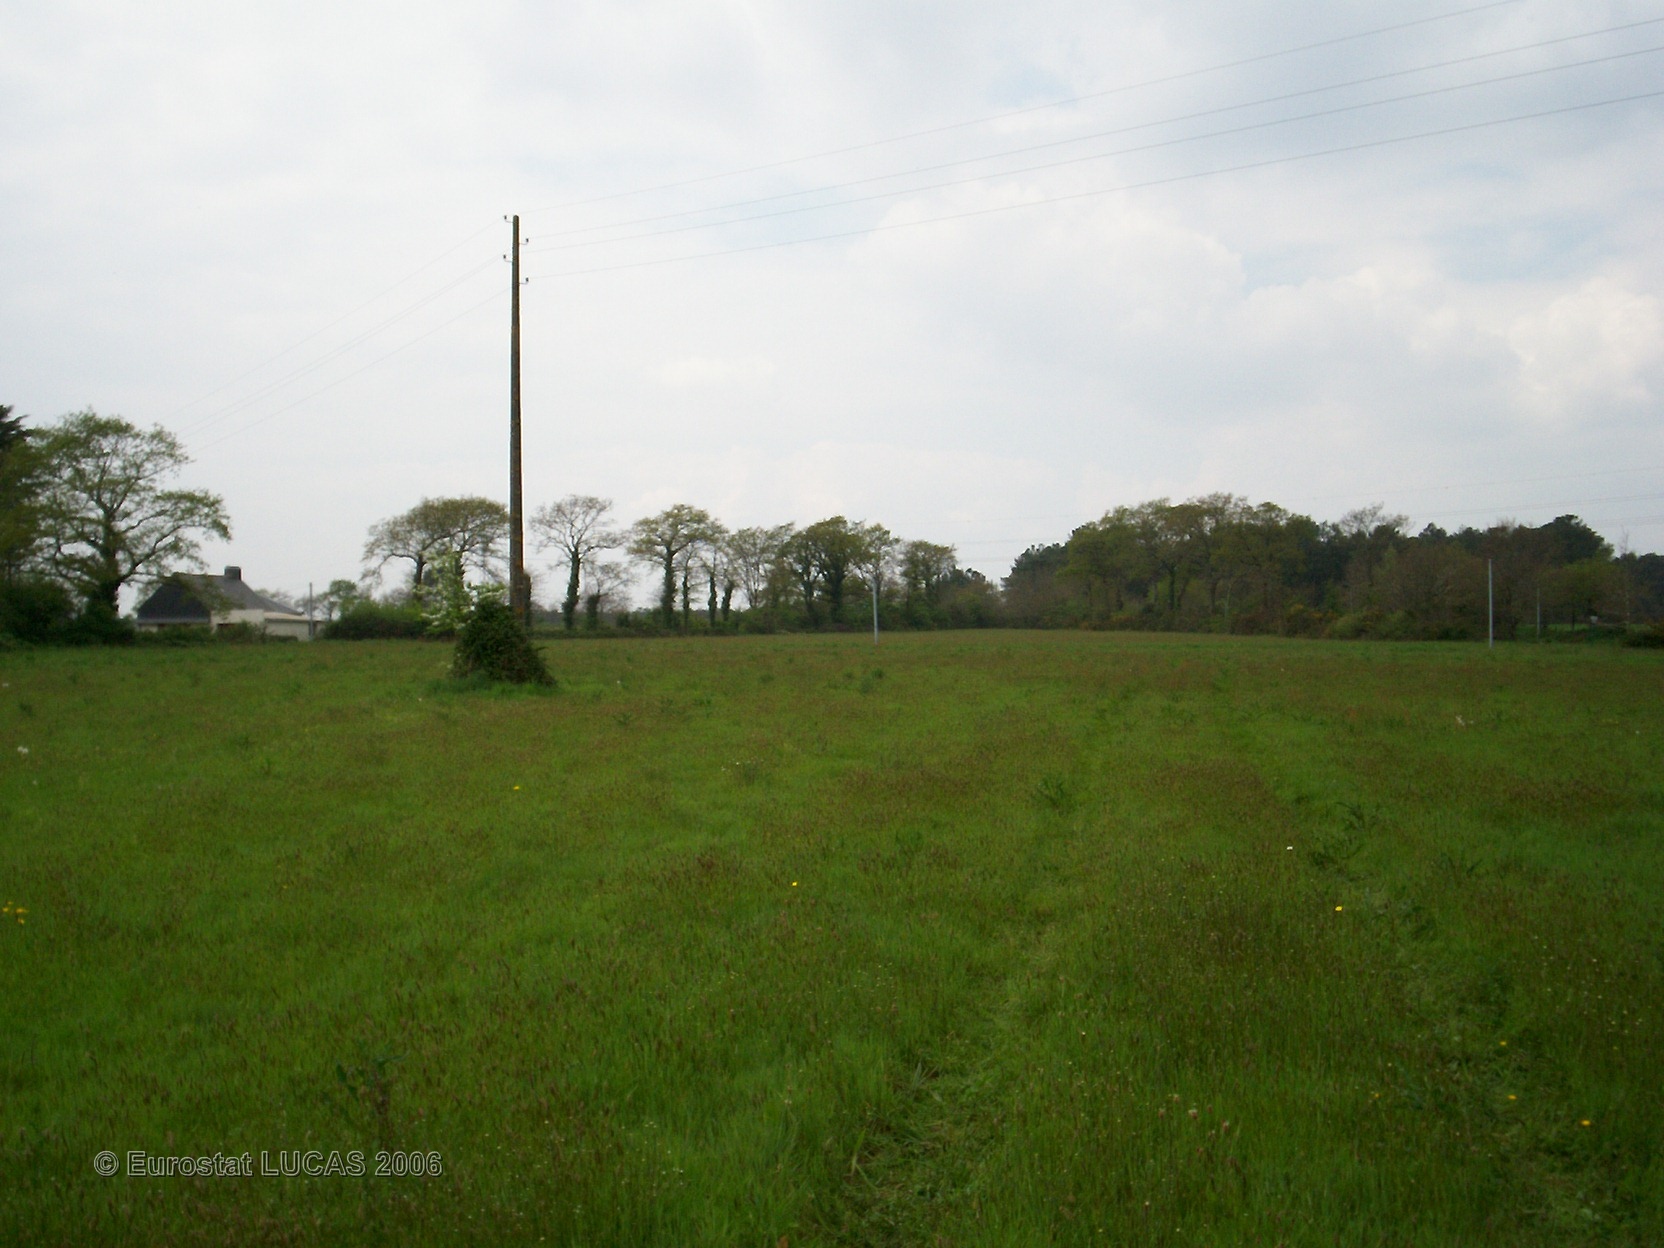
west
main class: Grassland
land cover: Grassland without tree/shrub cover
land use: Agriculture (excluding fallow land and kitchen gardens)
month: April
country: FR
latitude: 47.5823
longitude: -2.6511
